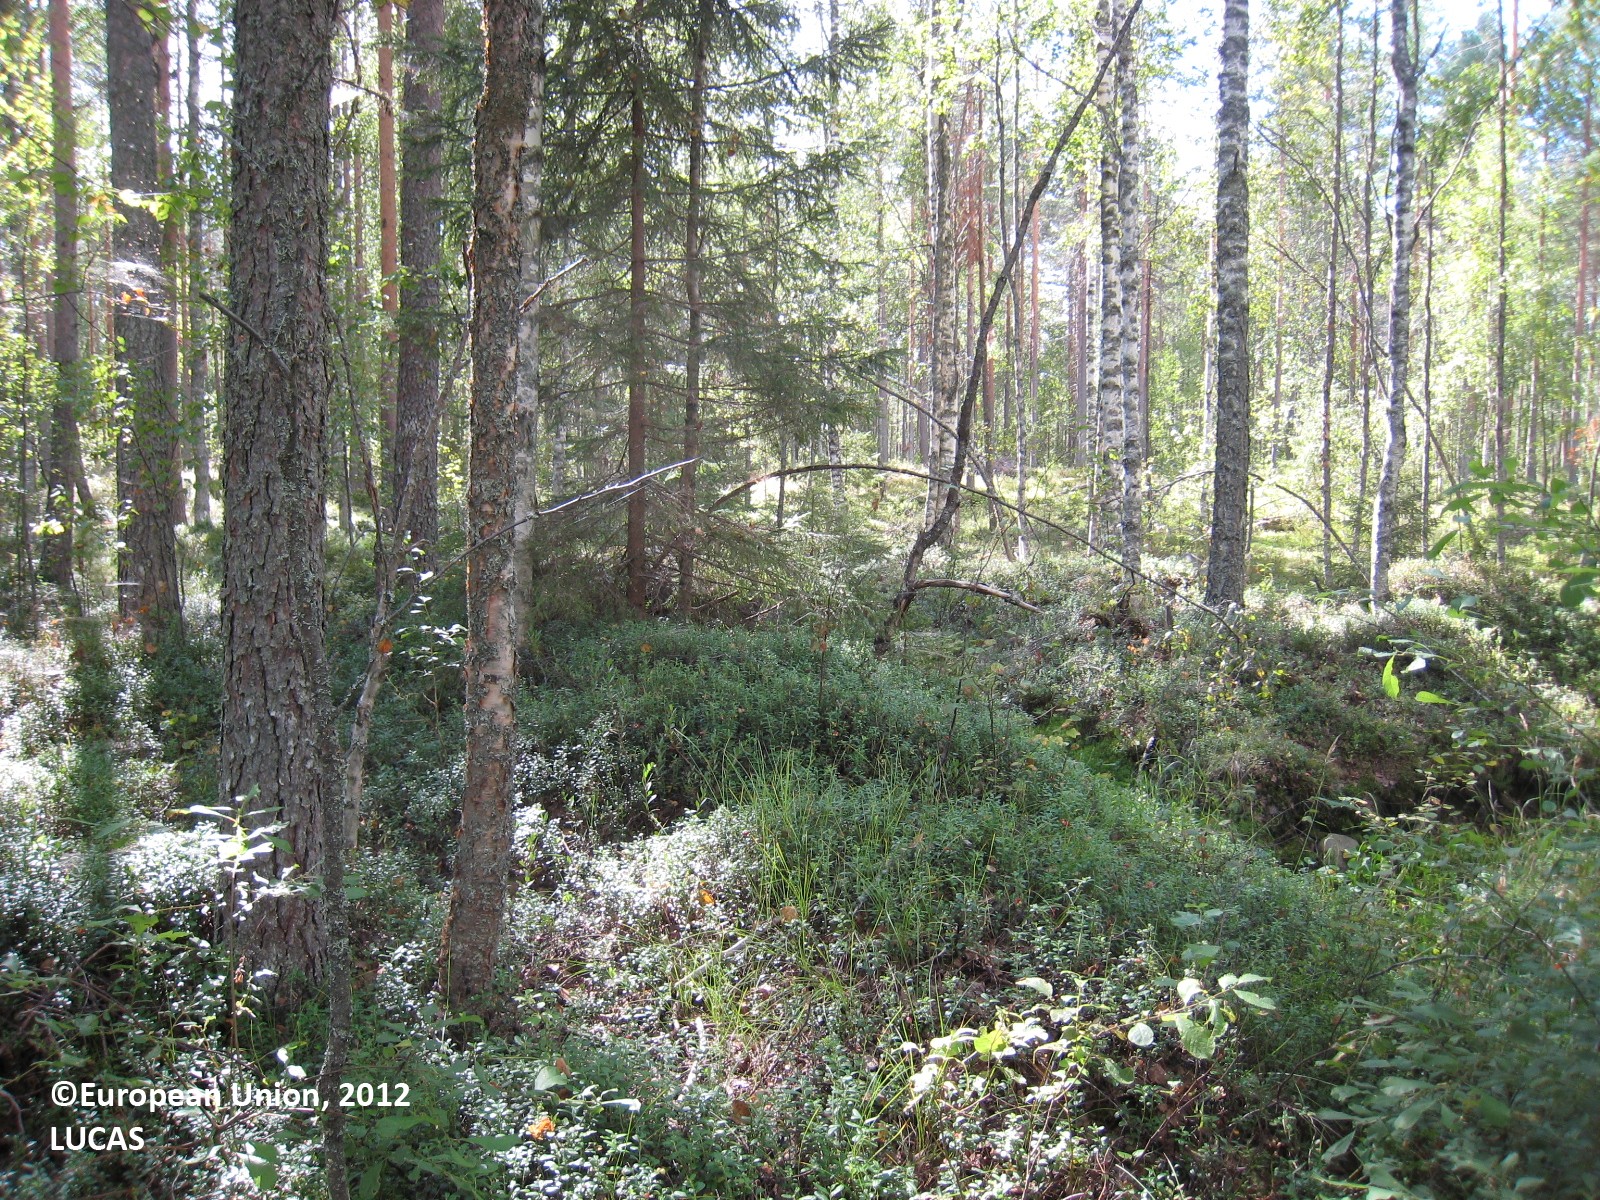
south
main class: Woodland
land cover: Pine dominated mixed woodland
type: boreal forest
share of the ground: > 75 %
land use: Forestry
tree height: > 5 m
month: August
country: FI
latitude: 61.9241
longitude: 27.3681
